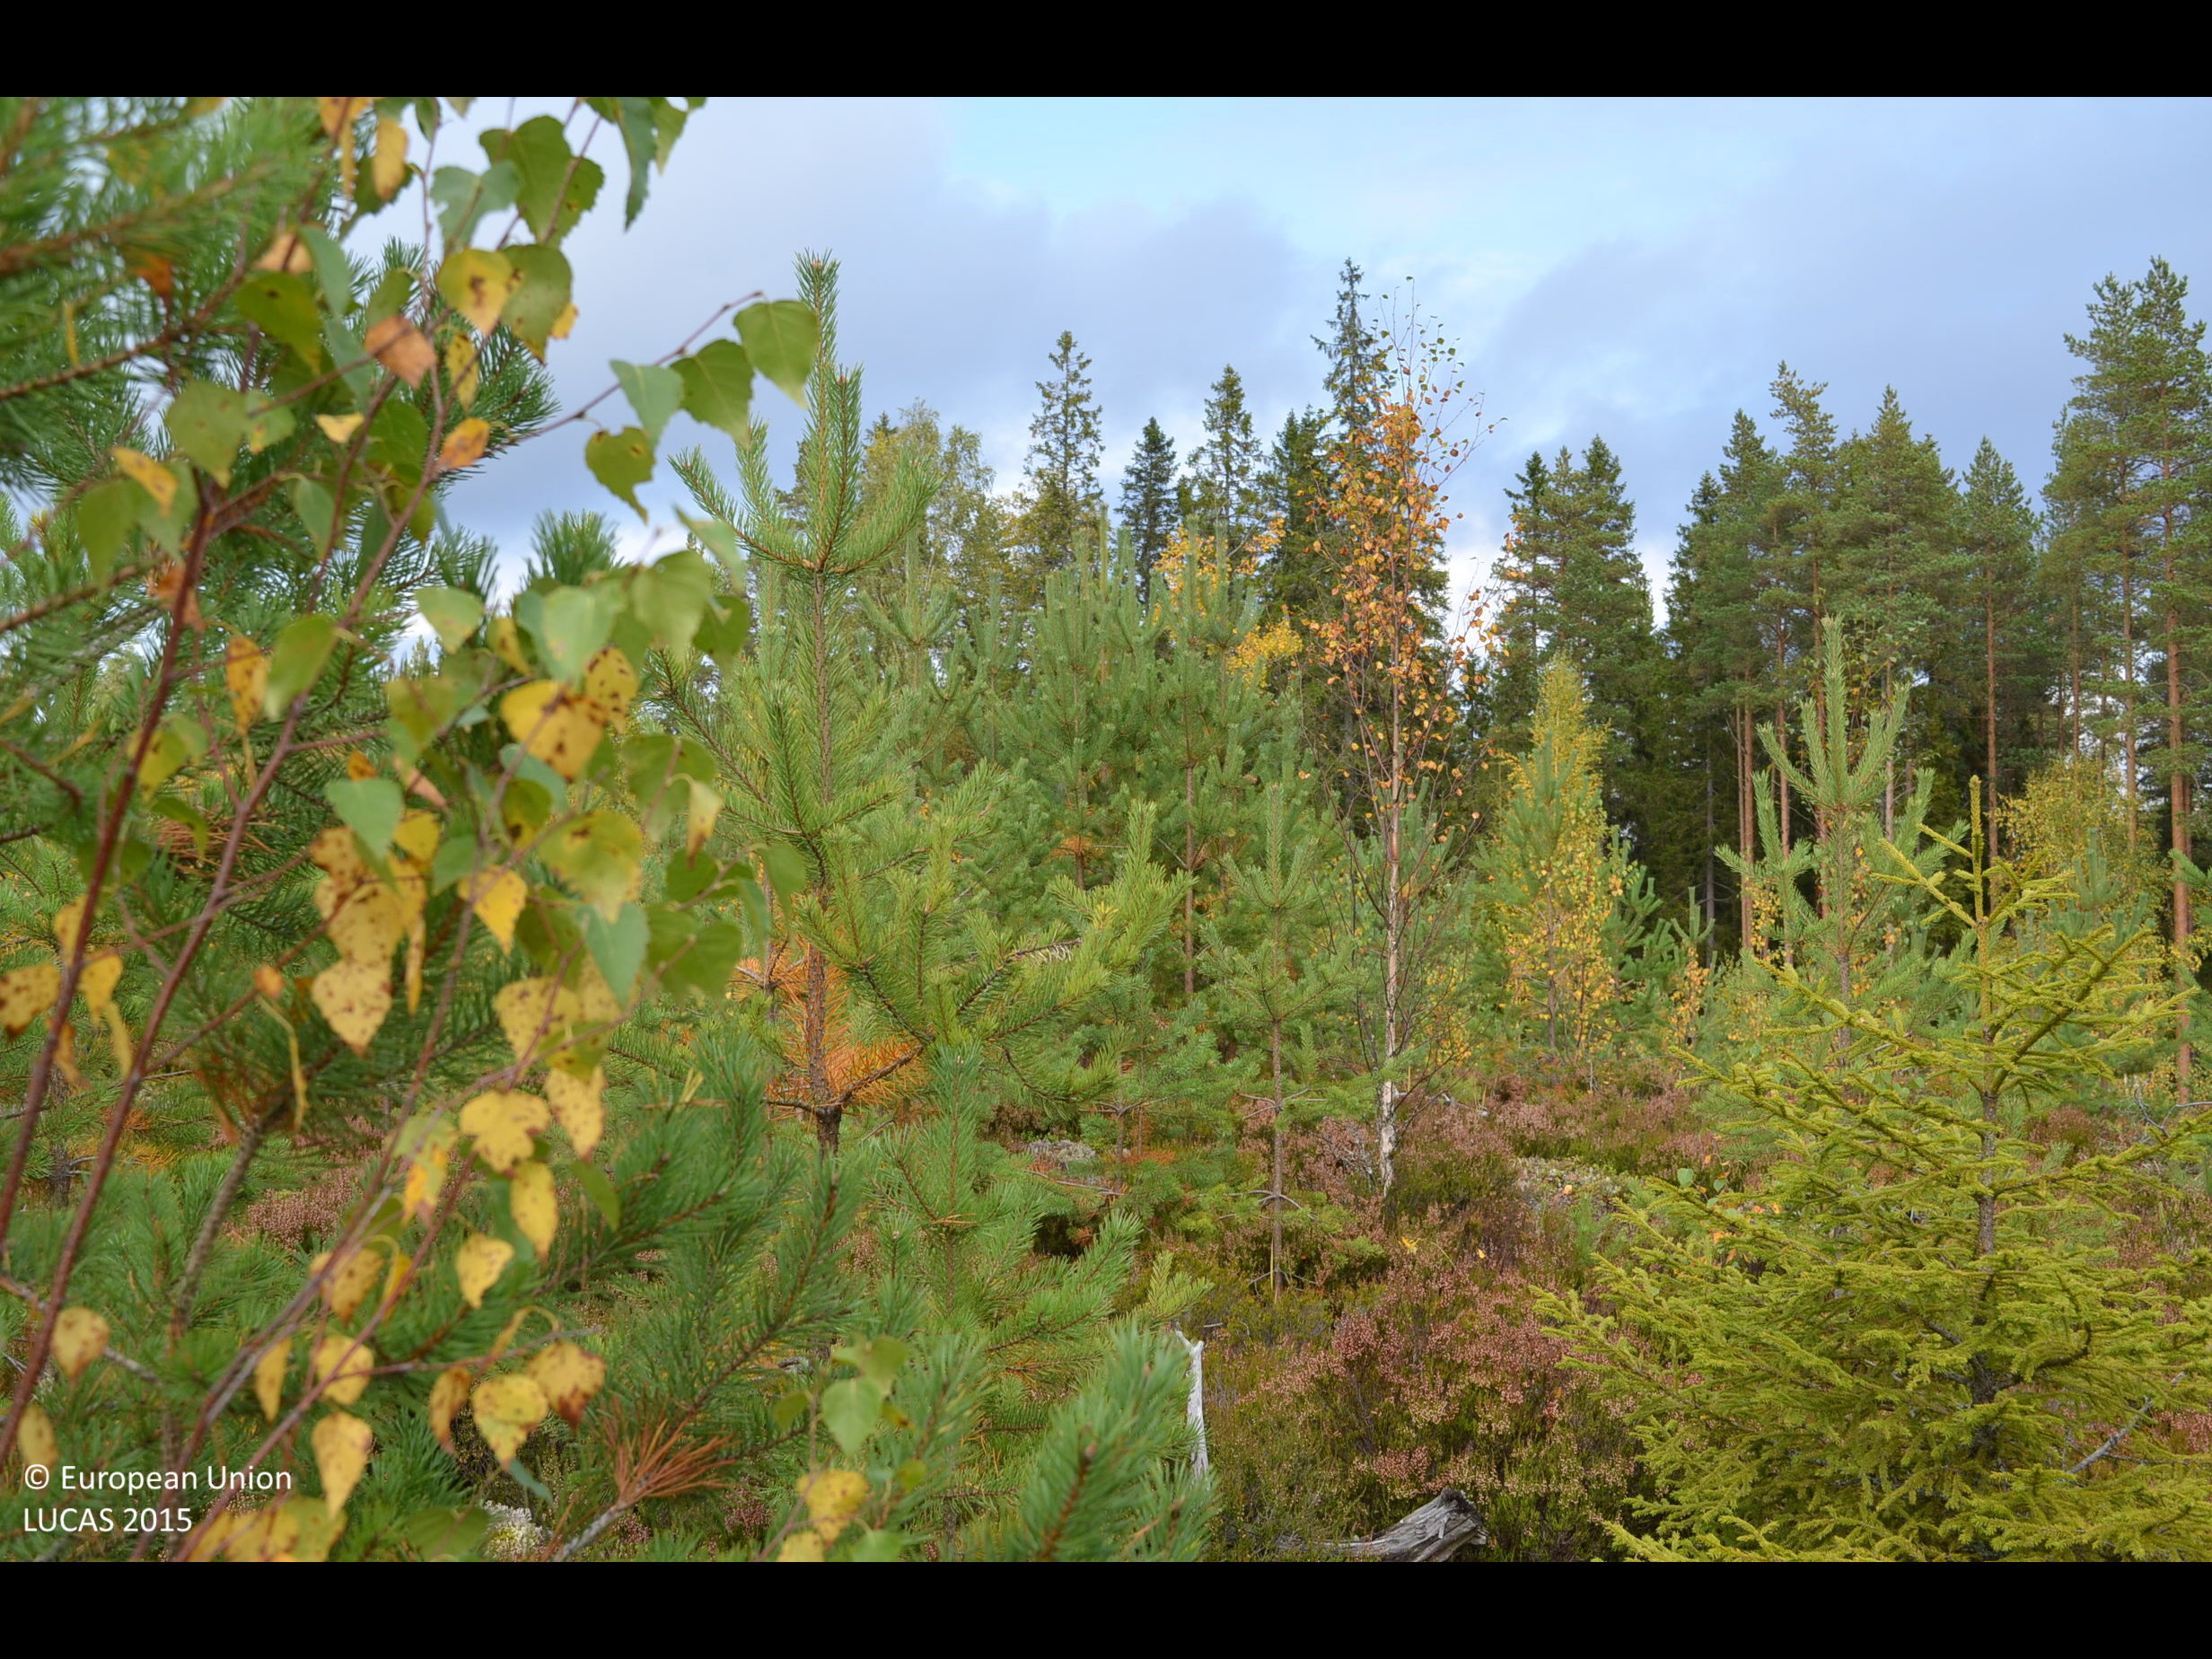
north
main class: Woodland
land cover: Pine dominated mixed woodland
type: boreal forest
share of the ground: 50 - 75 %
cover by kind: coniferous forest trees 35 %, shrubs 30 %, broadleaved forest trees 25 %, lichens and mosses 10 %
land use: Forestry
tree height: < 5 m
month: September
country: FI
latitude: 62.7269
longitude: 23.7865
